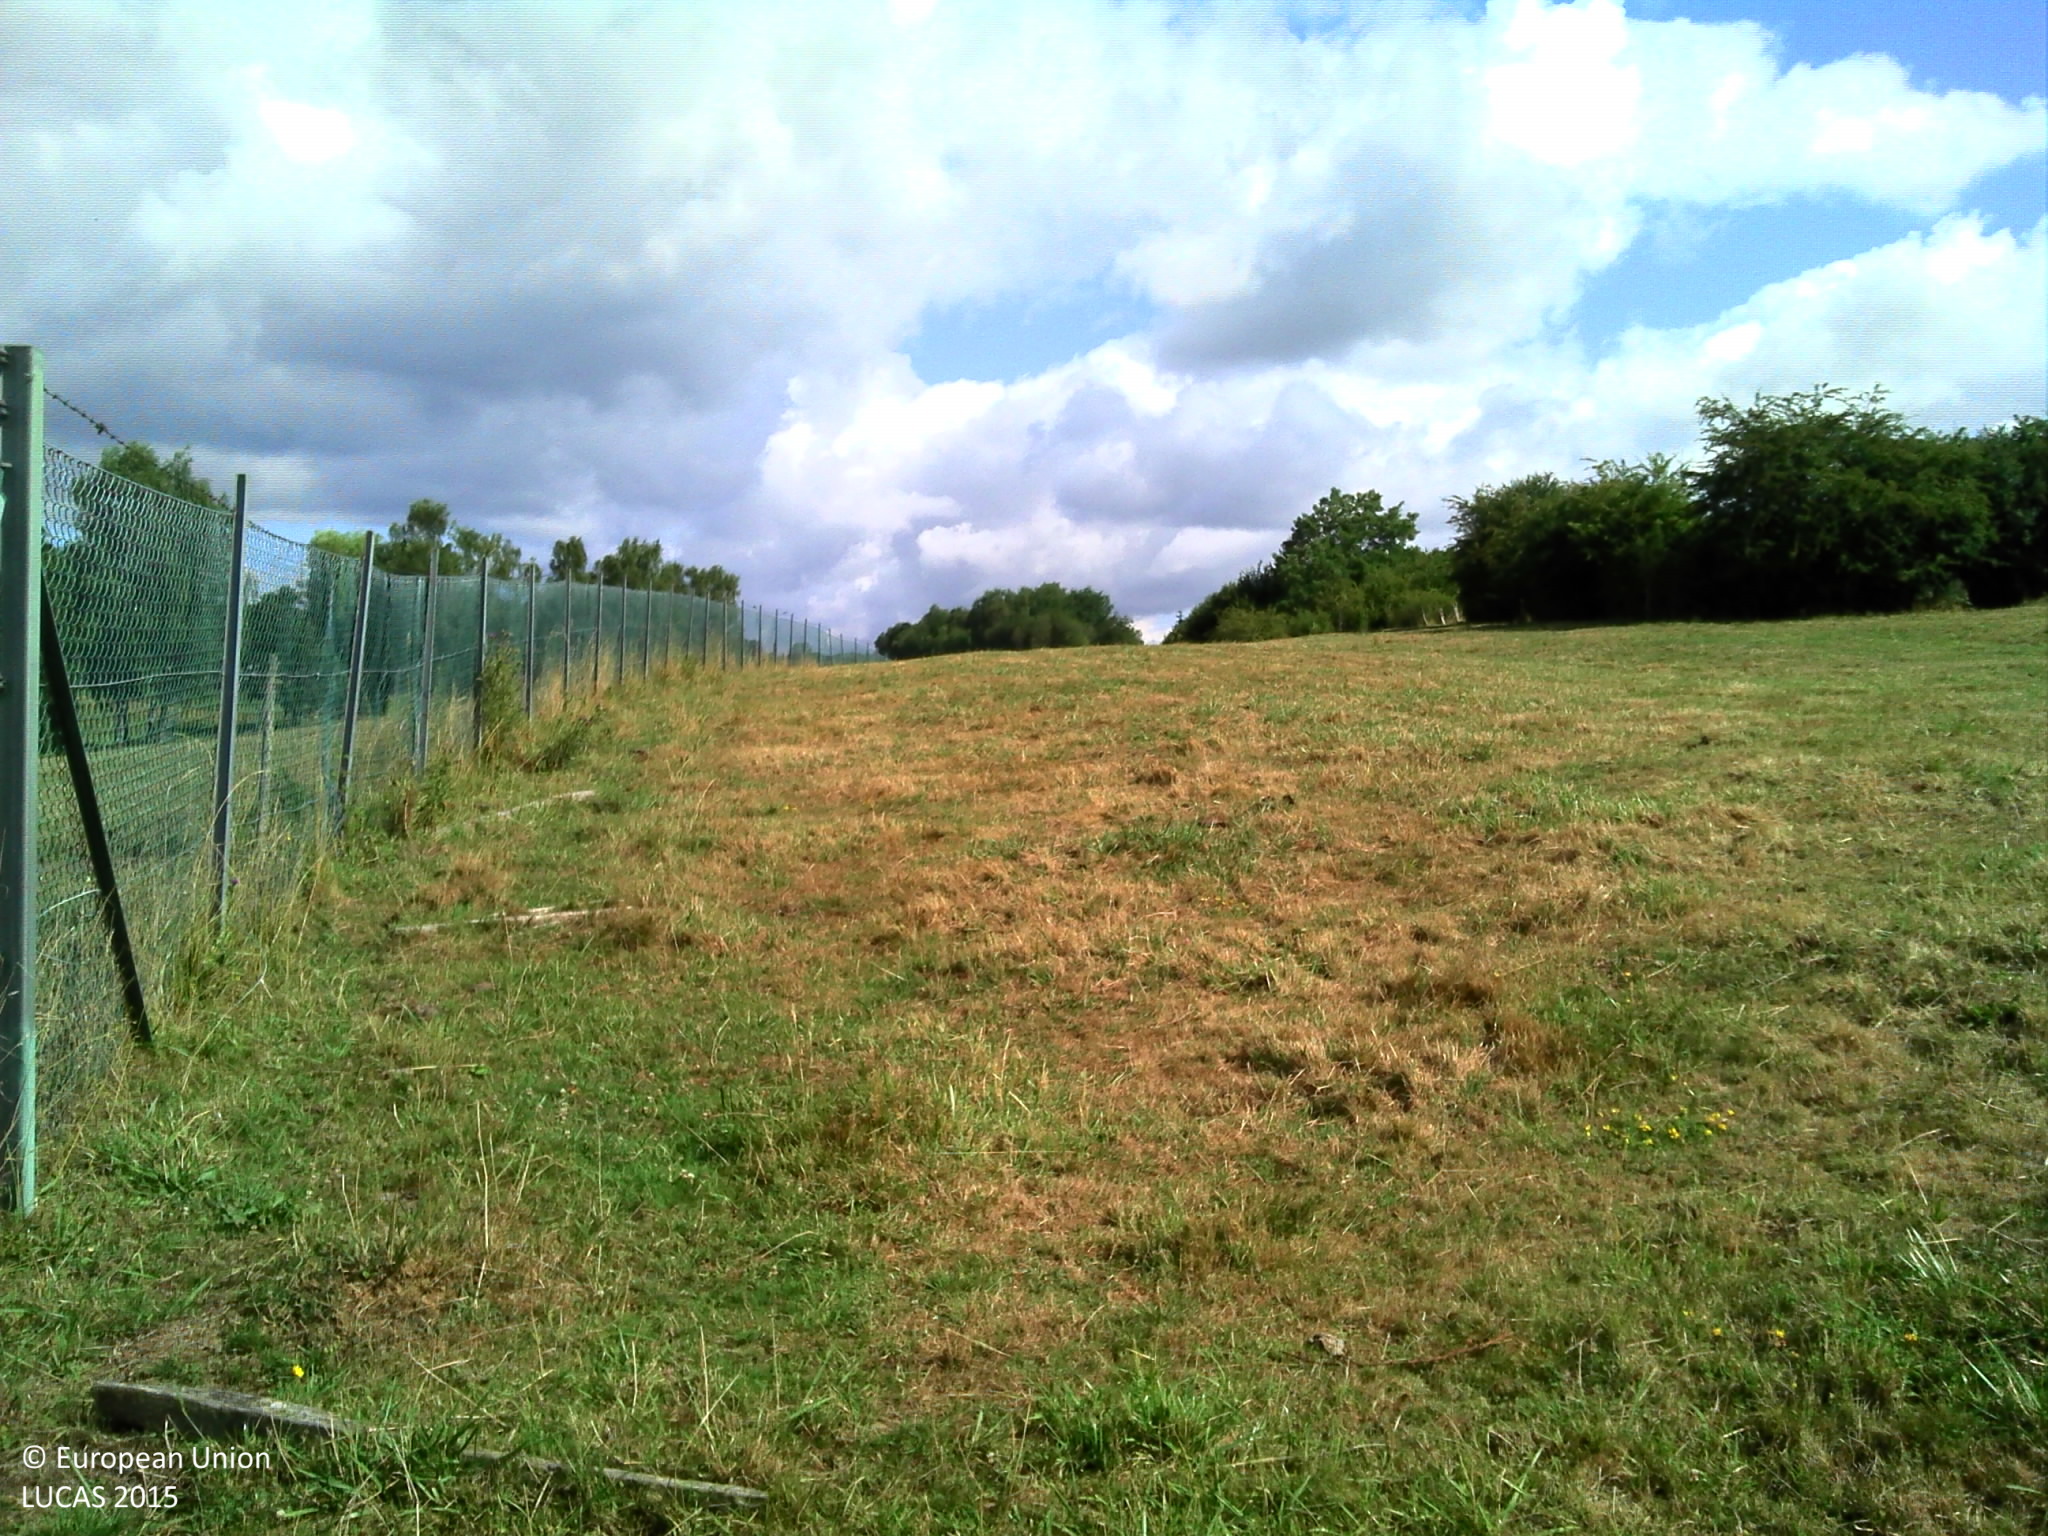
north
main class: Grassland
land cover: Grassland with sparse tree/shrub cover
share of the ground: > 75 %
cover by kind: herbaceous plants 95 %, broadleaved forest trees 5 %
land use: Amenities, museums, leisure
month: July
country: BE
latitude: 49.5607
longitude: 5.6438
